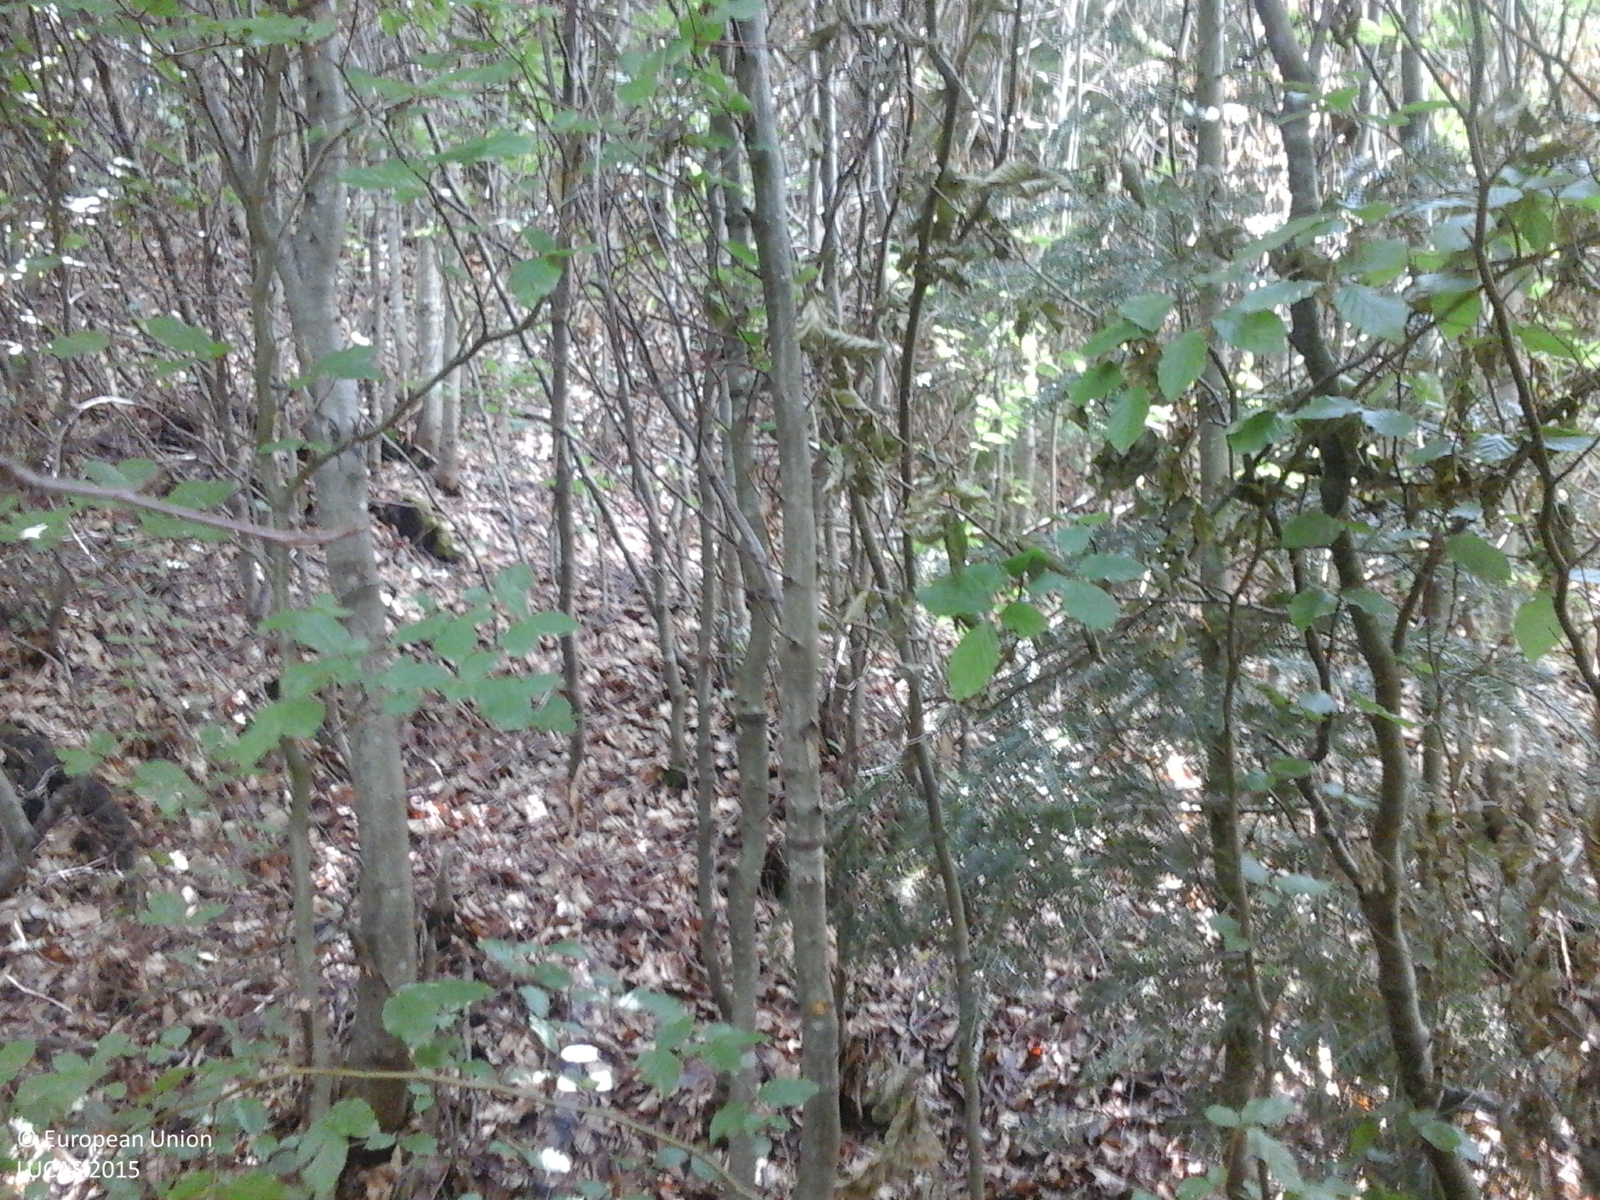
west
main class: Woodland
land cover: Other mixed woodland
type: beech forest
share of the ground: > 75 %
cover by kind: broadleaved forest trees 75 %, coniferous forest trees 25 %
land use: Forestry
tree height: > 5 m
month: July
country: RO
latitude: 45.3828
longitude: 24.5753
